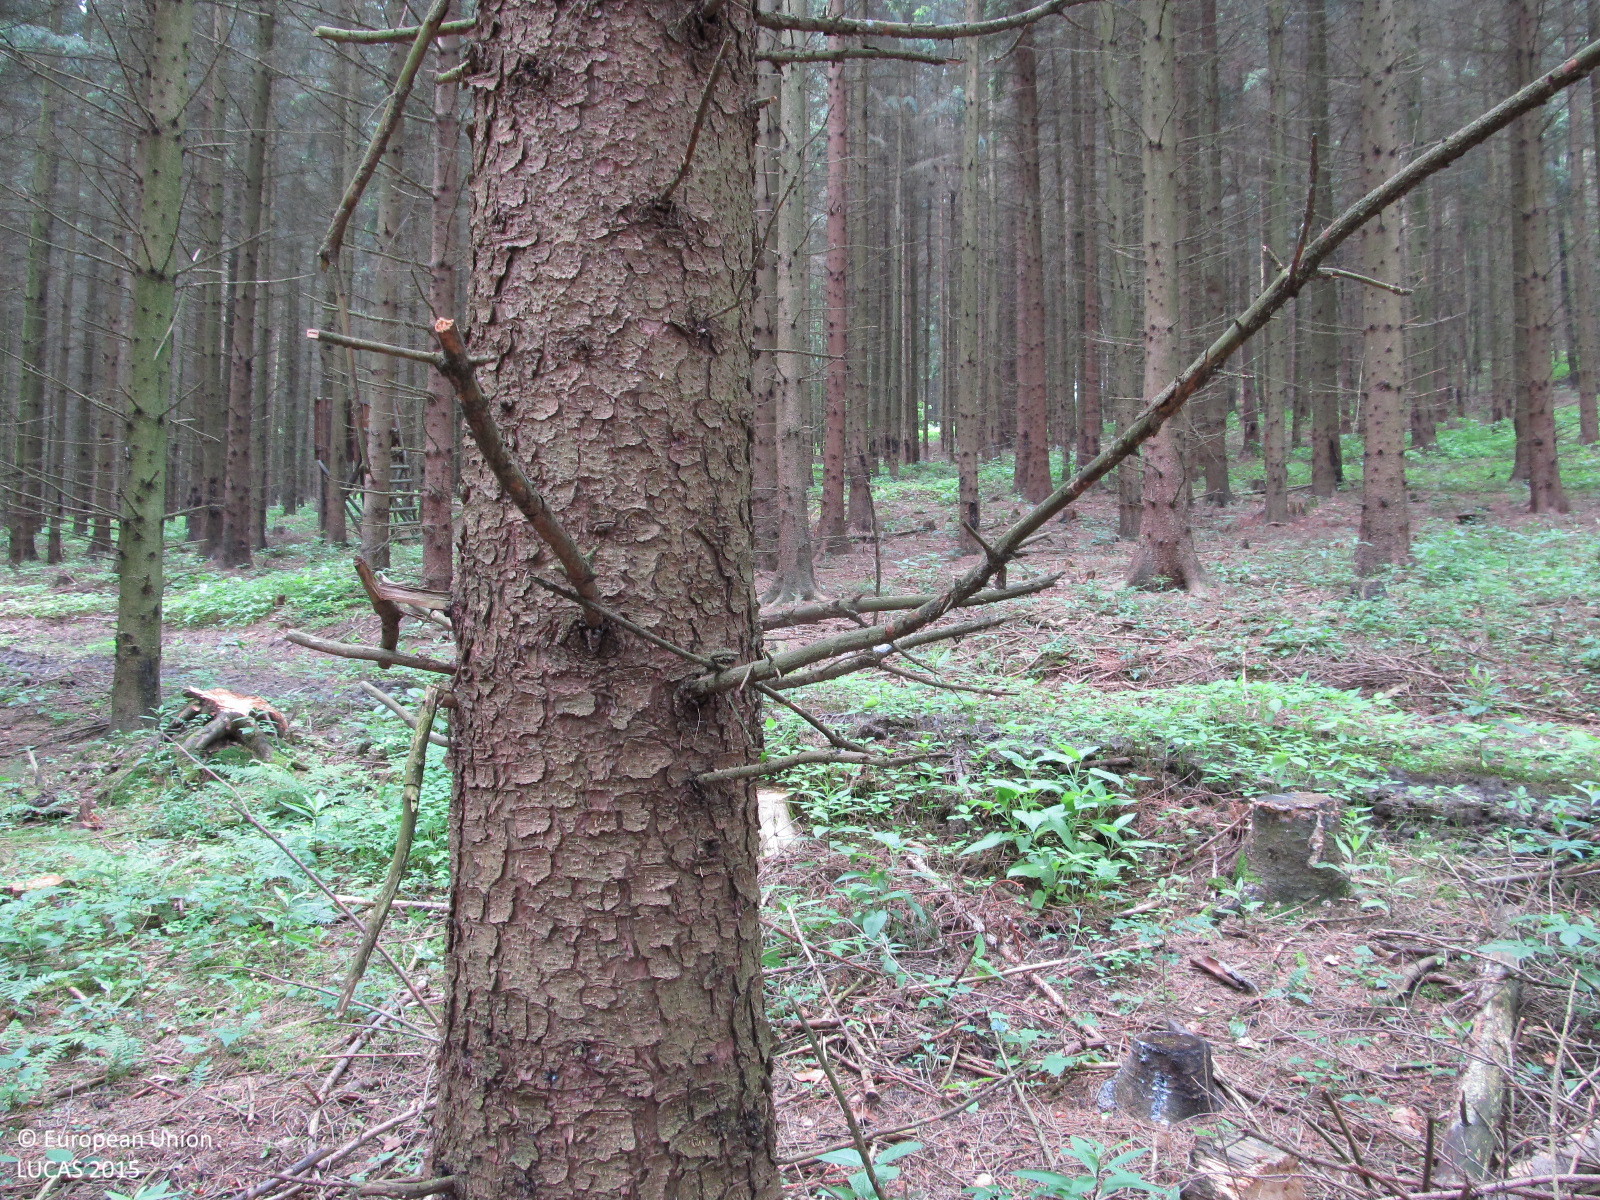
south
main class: Woodland
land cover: Spruce dominated coniferous woodland
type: hemiboreal forest and nemoral coniferous forest and mixed broadleaved-coniferous forest
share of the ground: > 75 %
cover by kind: coniferous forest trees 80 %, unconsolidated bare surface 20 %
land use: Forestry
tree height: > 5 m
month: June
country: AT
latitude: 48.5776
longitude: 15.4108
